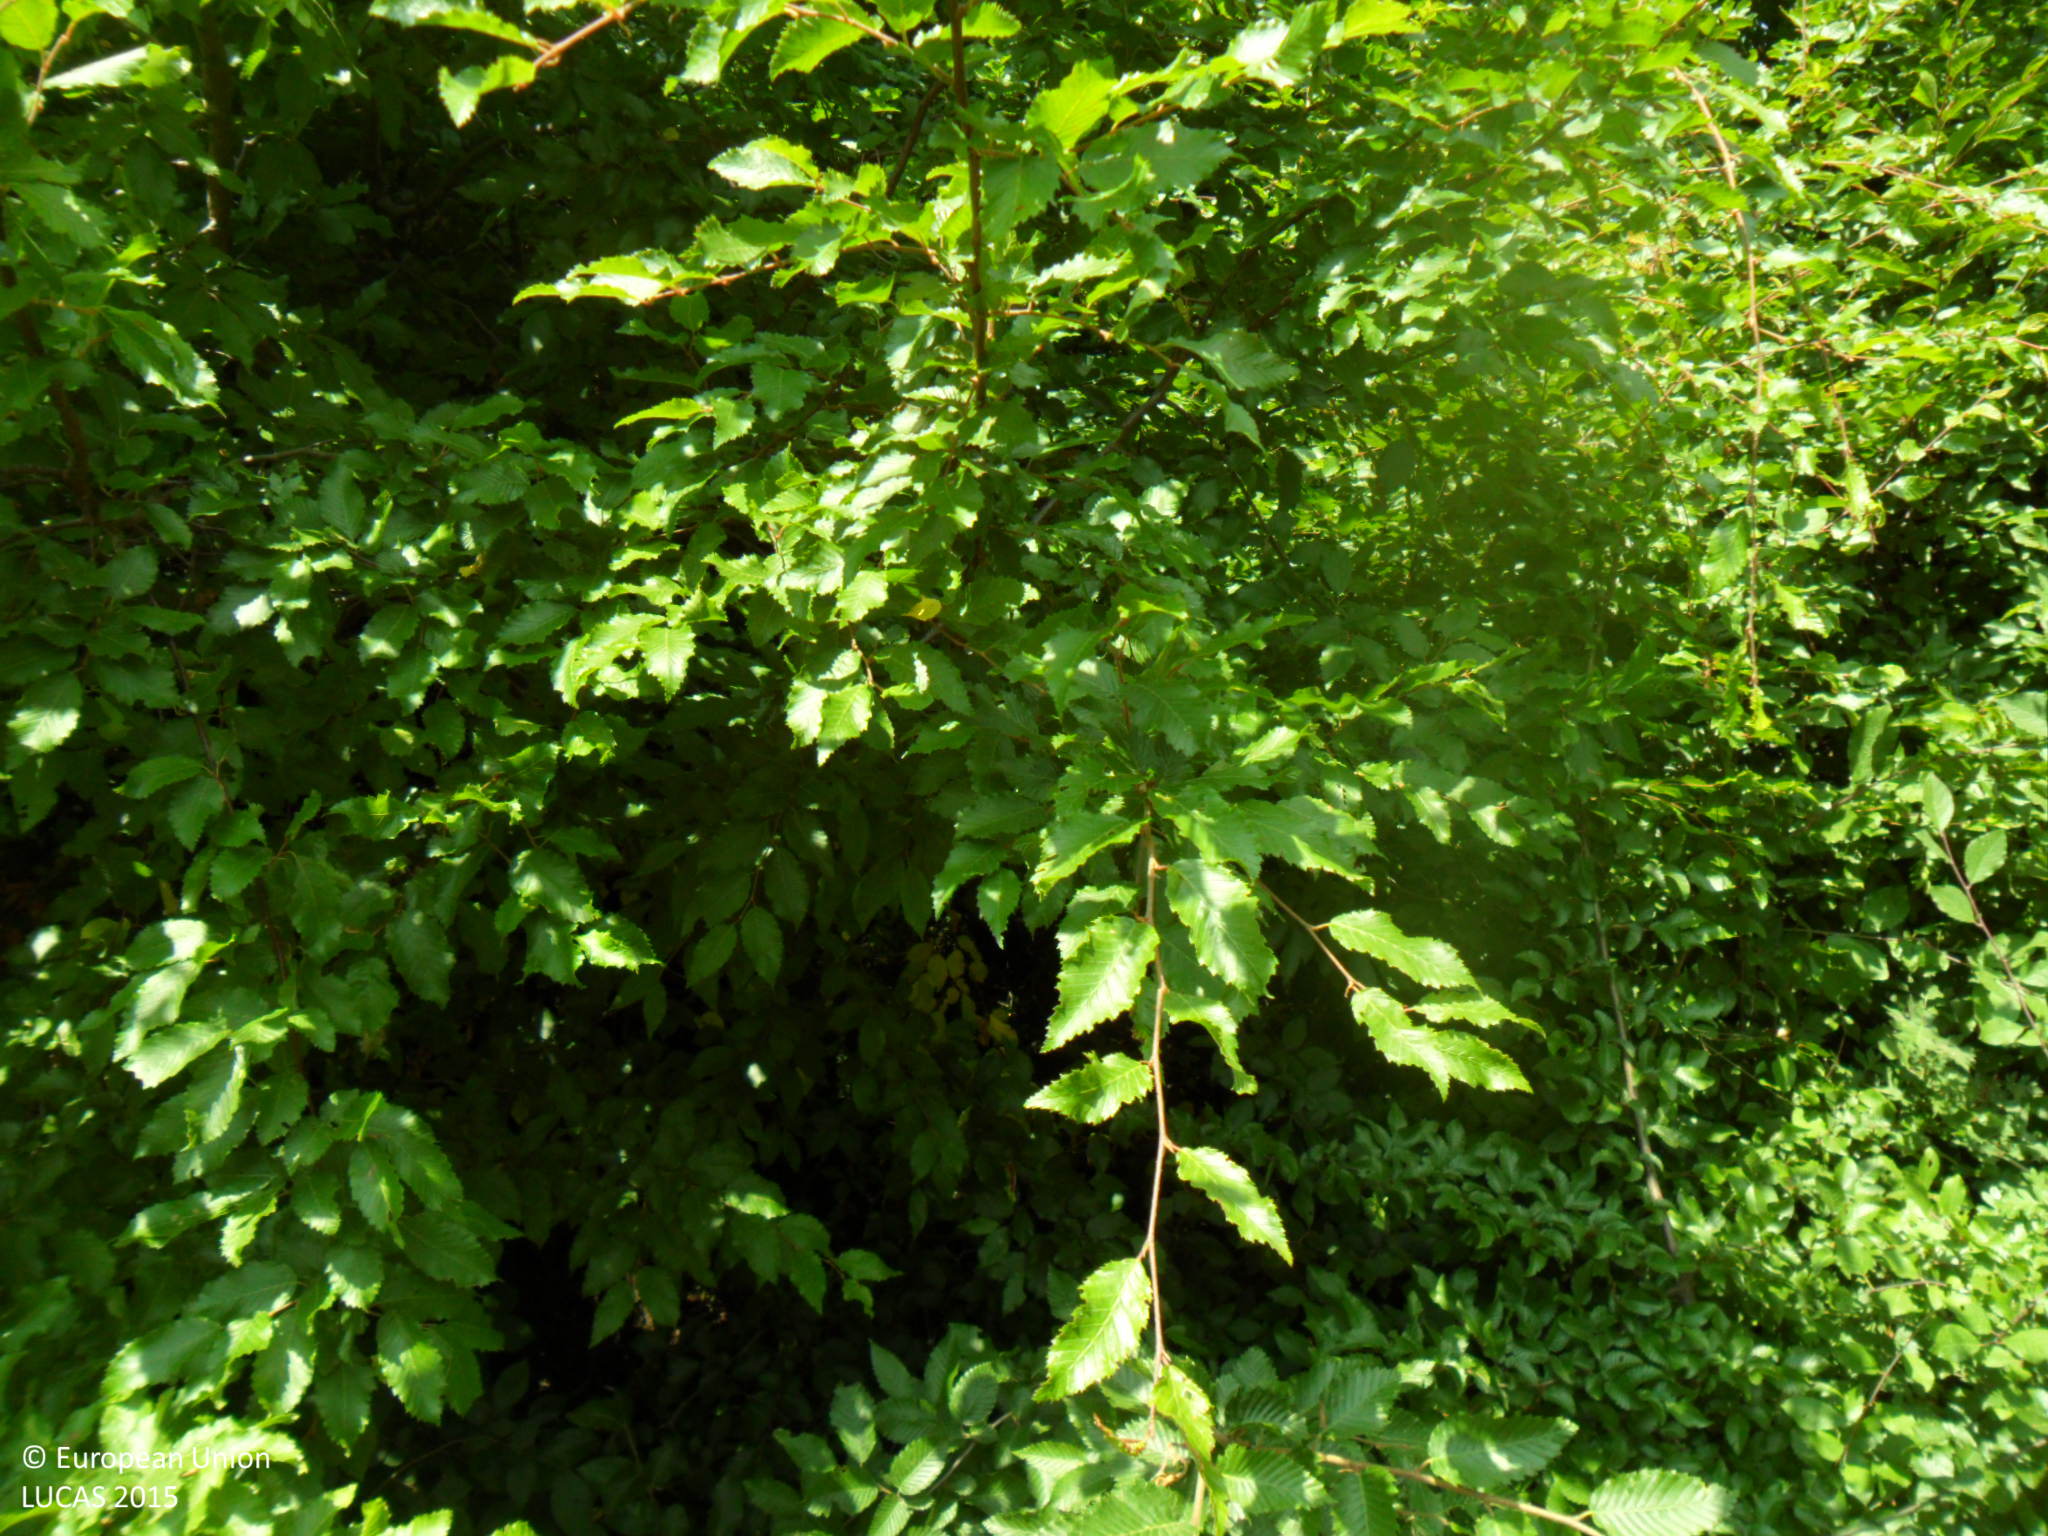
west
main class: Woodland
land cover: Broadleaved woodland
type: mesophytic deciduous forest
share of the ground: > 75 %
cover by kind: broadleaved forest trees 95 %, shrubs 5 %
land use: Forestry
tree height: > 5 m
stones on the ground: 10 - 25 %
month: June
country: BG
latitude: 43.4408
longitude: 27.0575
